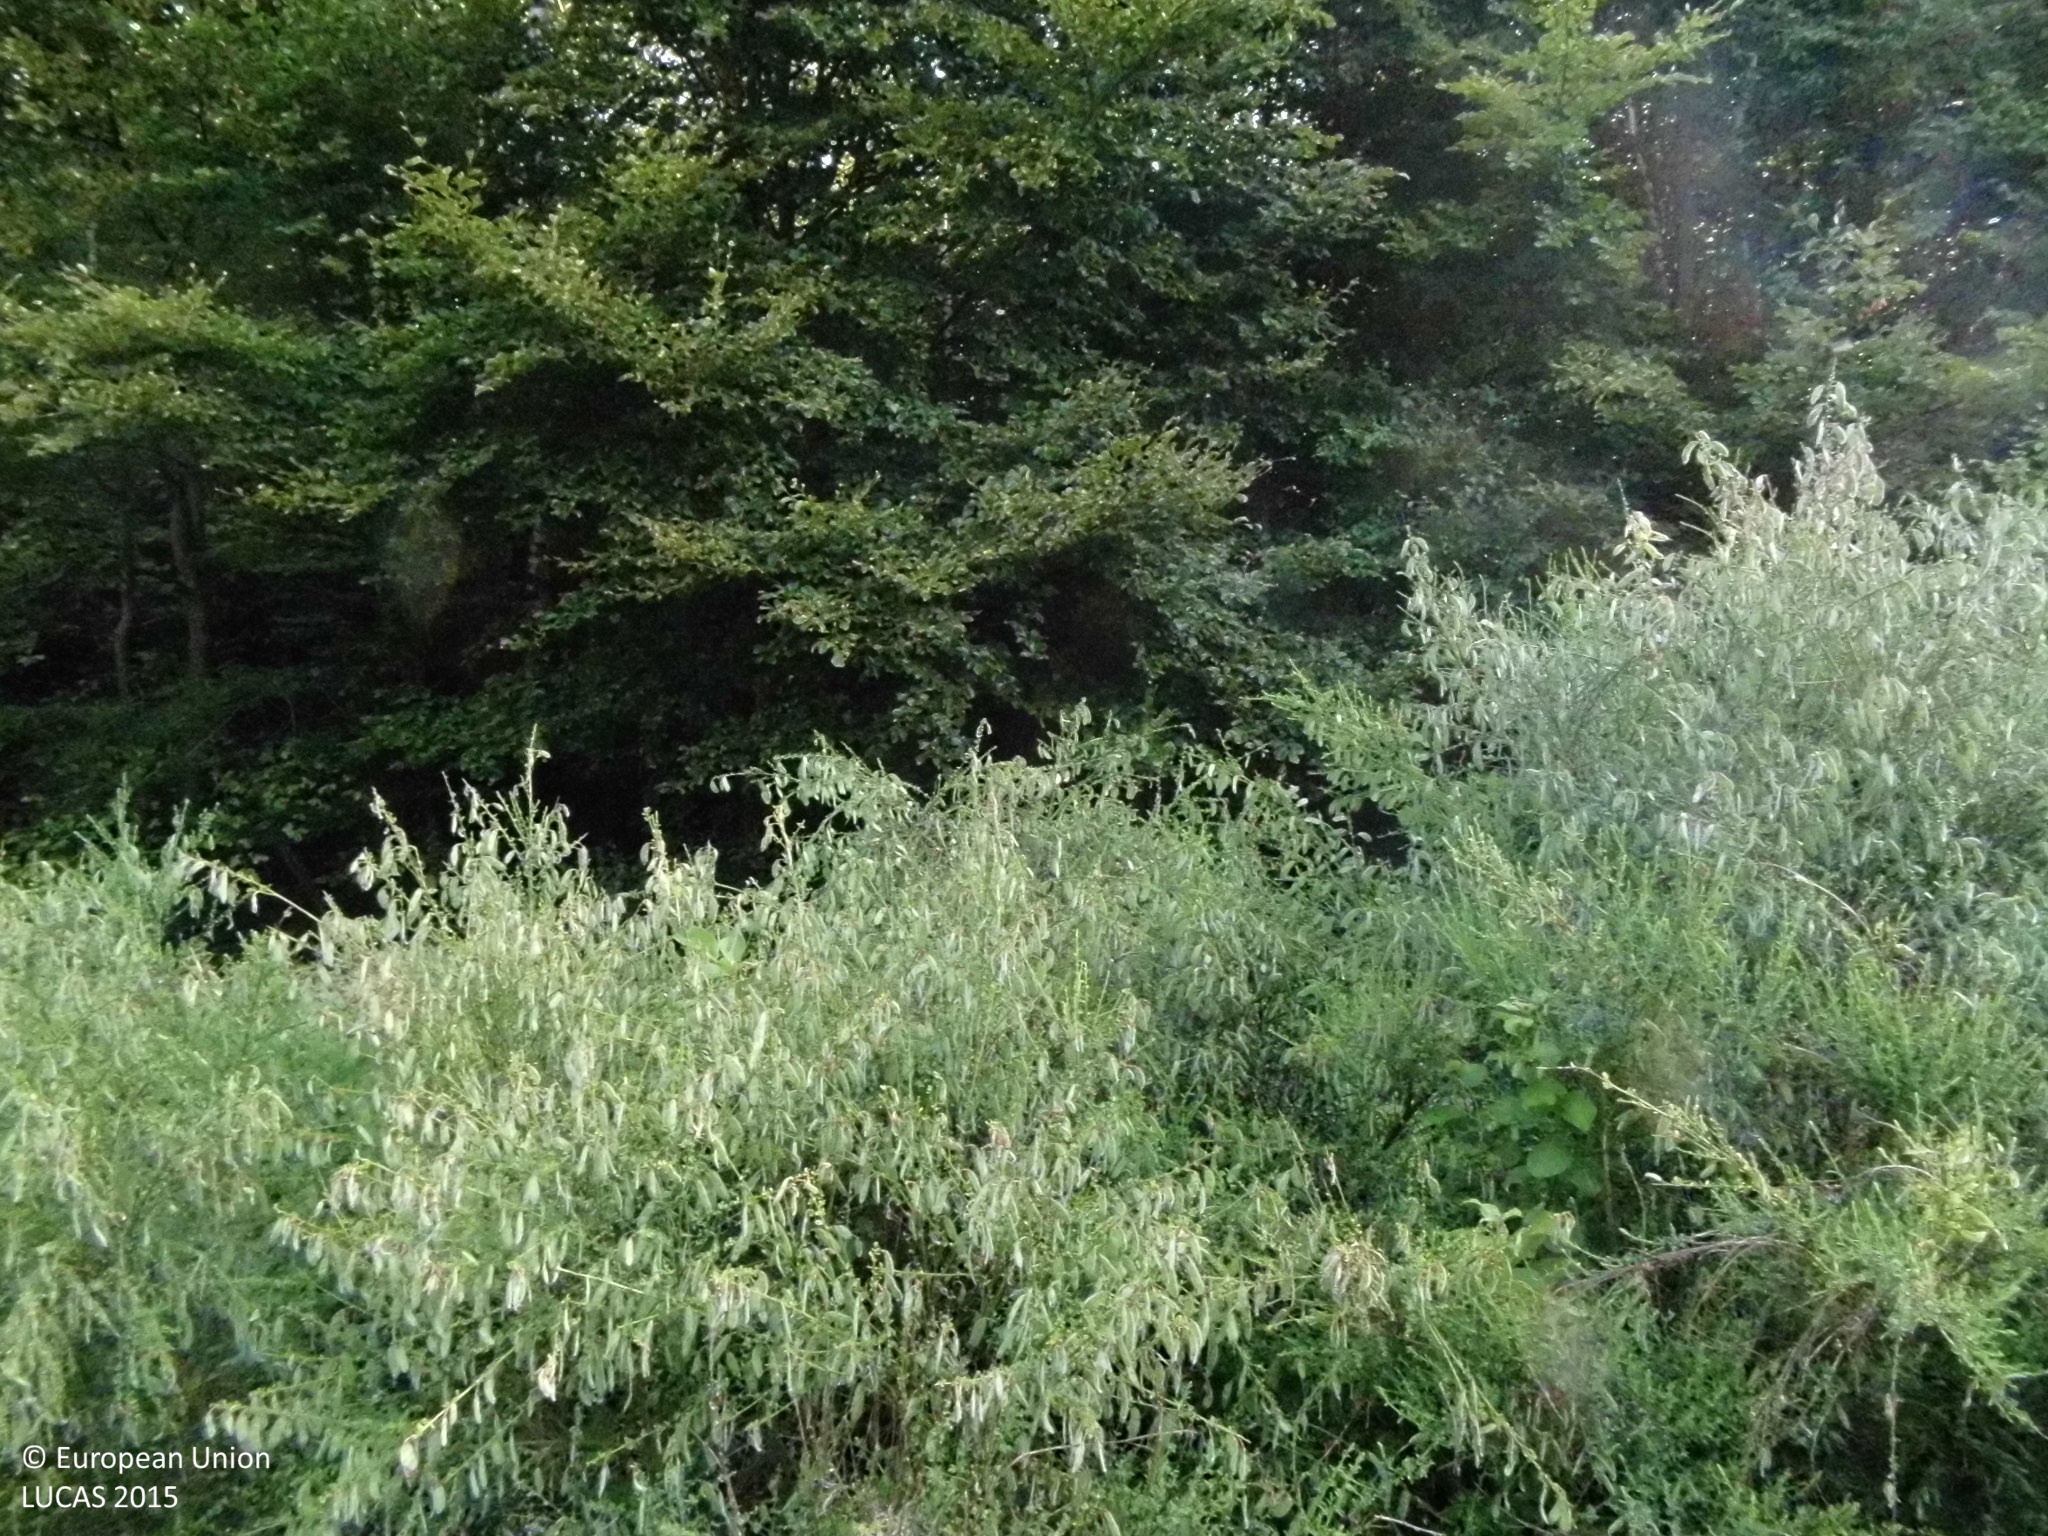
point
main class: Woodland
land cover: Broadleaved woodland
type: mesophytic deciduous forest
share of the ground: > 75 %
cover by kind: broadleaved forest trees 100 %
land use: Forestry
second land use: Amenities, museums, leisure
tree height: > 5 m
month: July
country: DE
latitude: 51.2639
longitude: 8.0083
